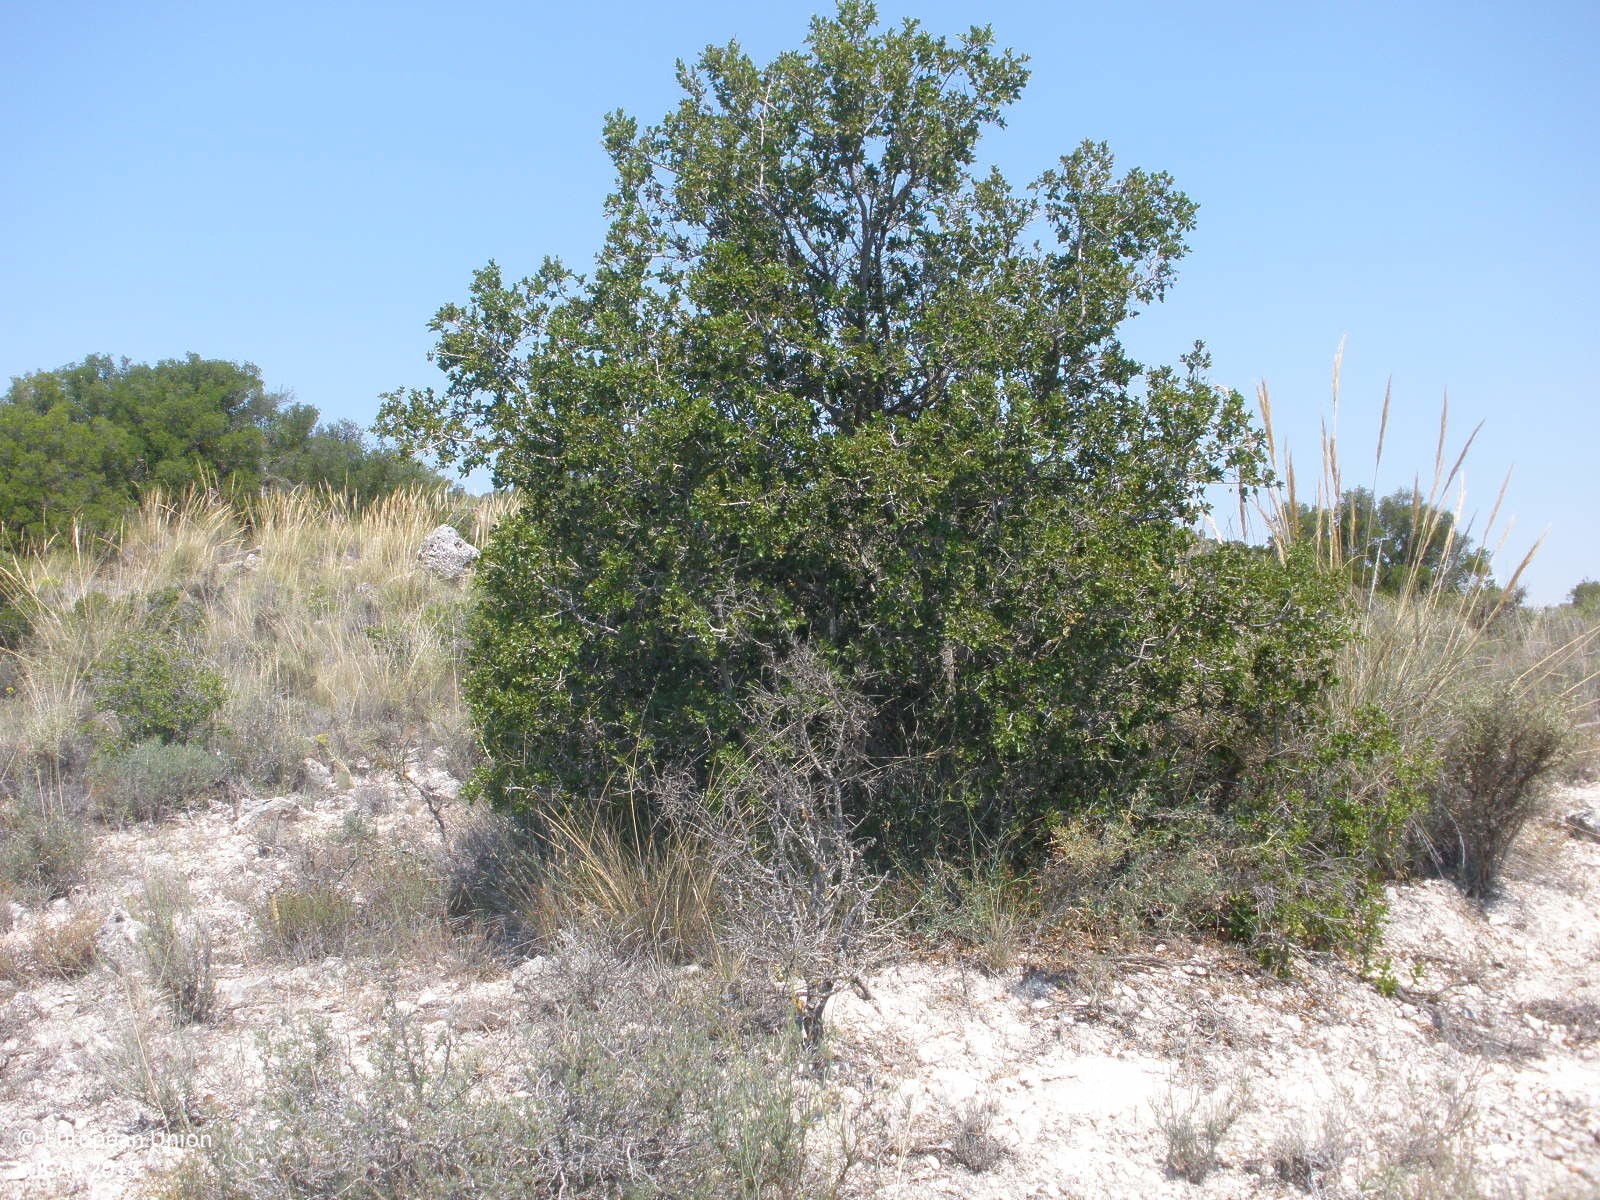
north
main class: Woodland
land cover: Broadleaved woodland
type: broadleaved evergreen forest
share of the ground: 10 - 25 %
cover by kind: shrubs 55 %, herbaceous plants 20 %, broadleaved forest trees 15 %, consolidated bare surface 10 %
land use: Semi-natural and natural areas not in use
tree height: < 5 m
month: June
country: ES
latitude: 40.2843
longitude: -3.2151
